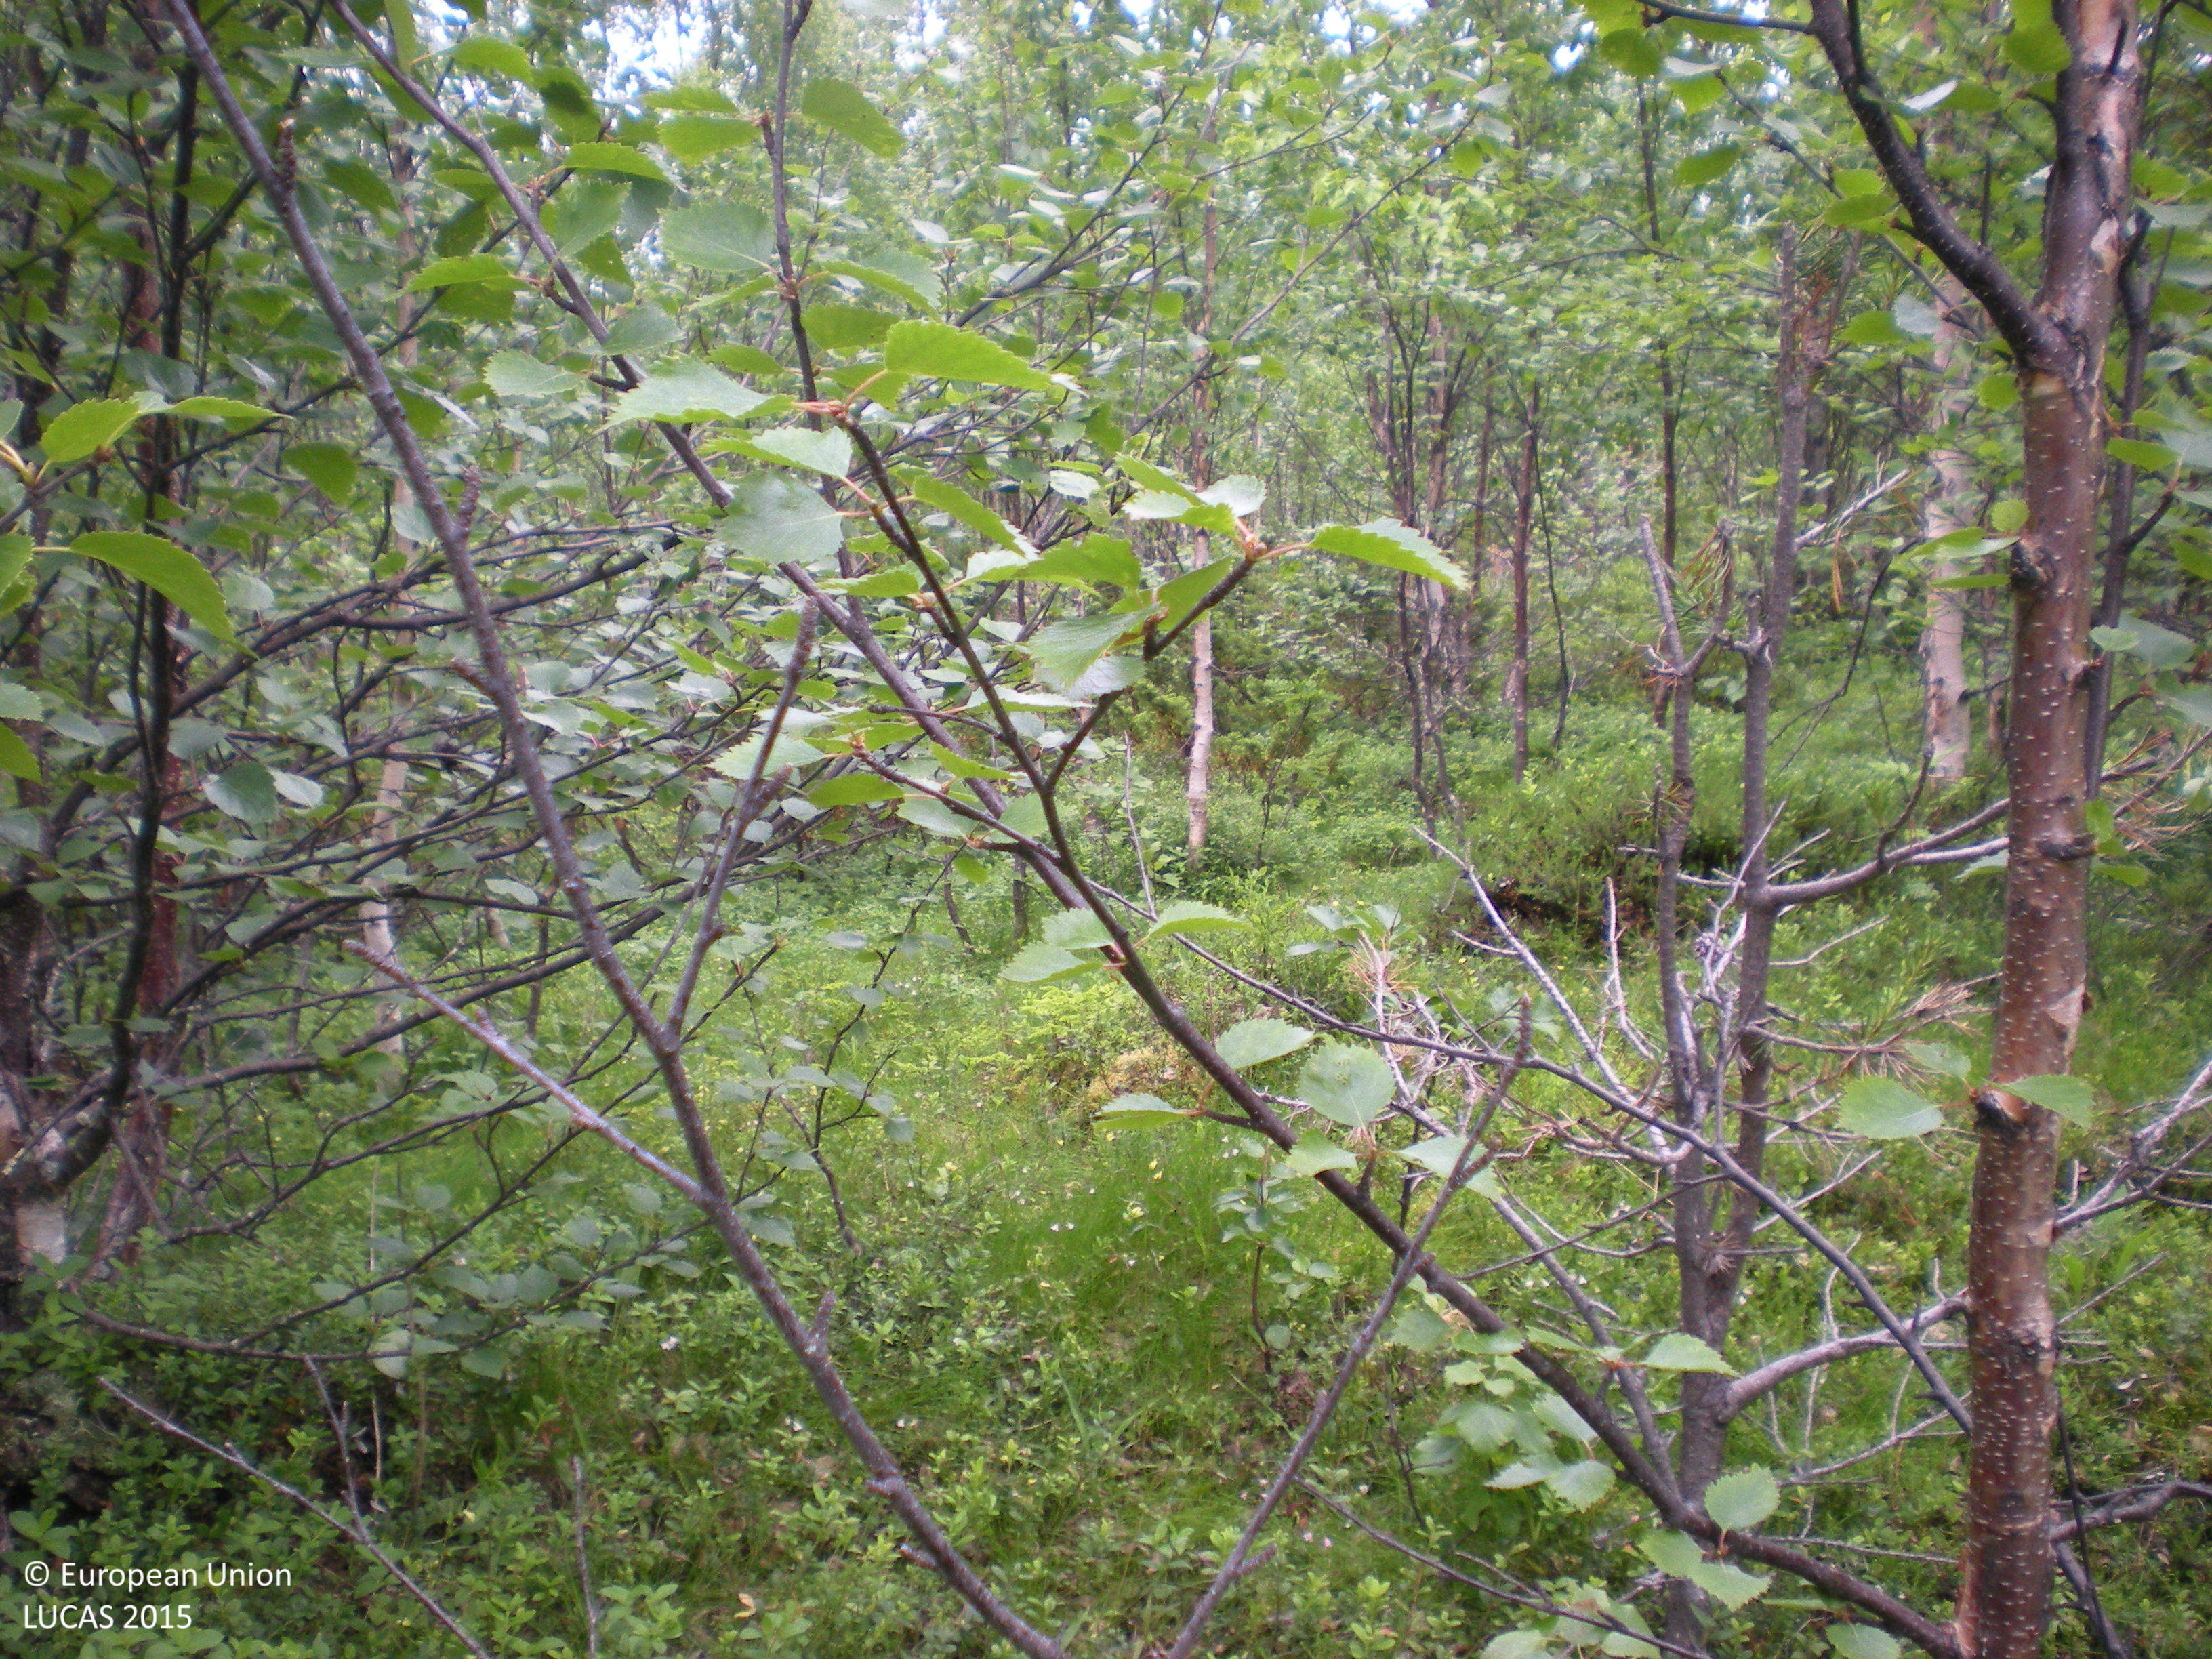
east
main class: Woodland
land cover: Broadleaved woodland
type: boreal forest
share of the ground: 50 - 75 %
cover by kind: broadleaved forest trees 65 %, herbaceous plants 20 %, shrubs 10 %, lichens and mosses 5 %
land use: Forestry
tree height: < 5 m
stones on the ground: > 50 %
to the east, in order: Broadleaved woodland; Other mixed woodland; Pine dominated mixed woodland
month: August
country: SE
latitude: 66.2613
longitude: 17.3670
